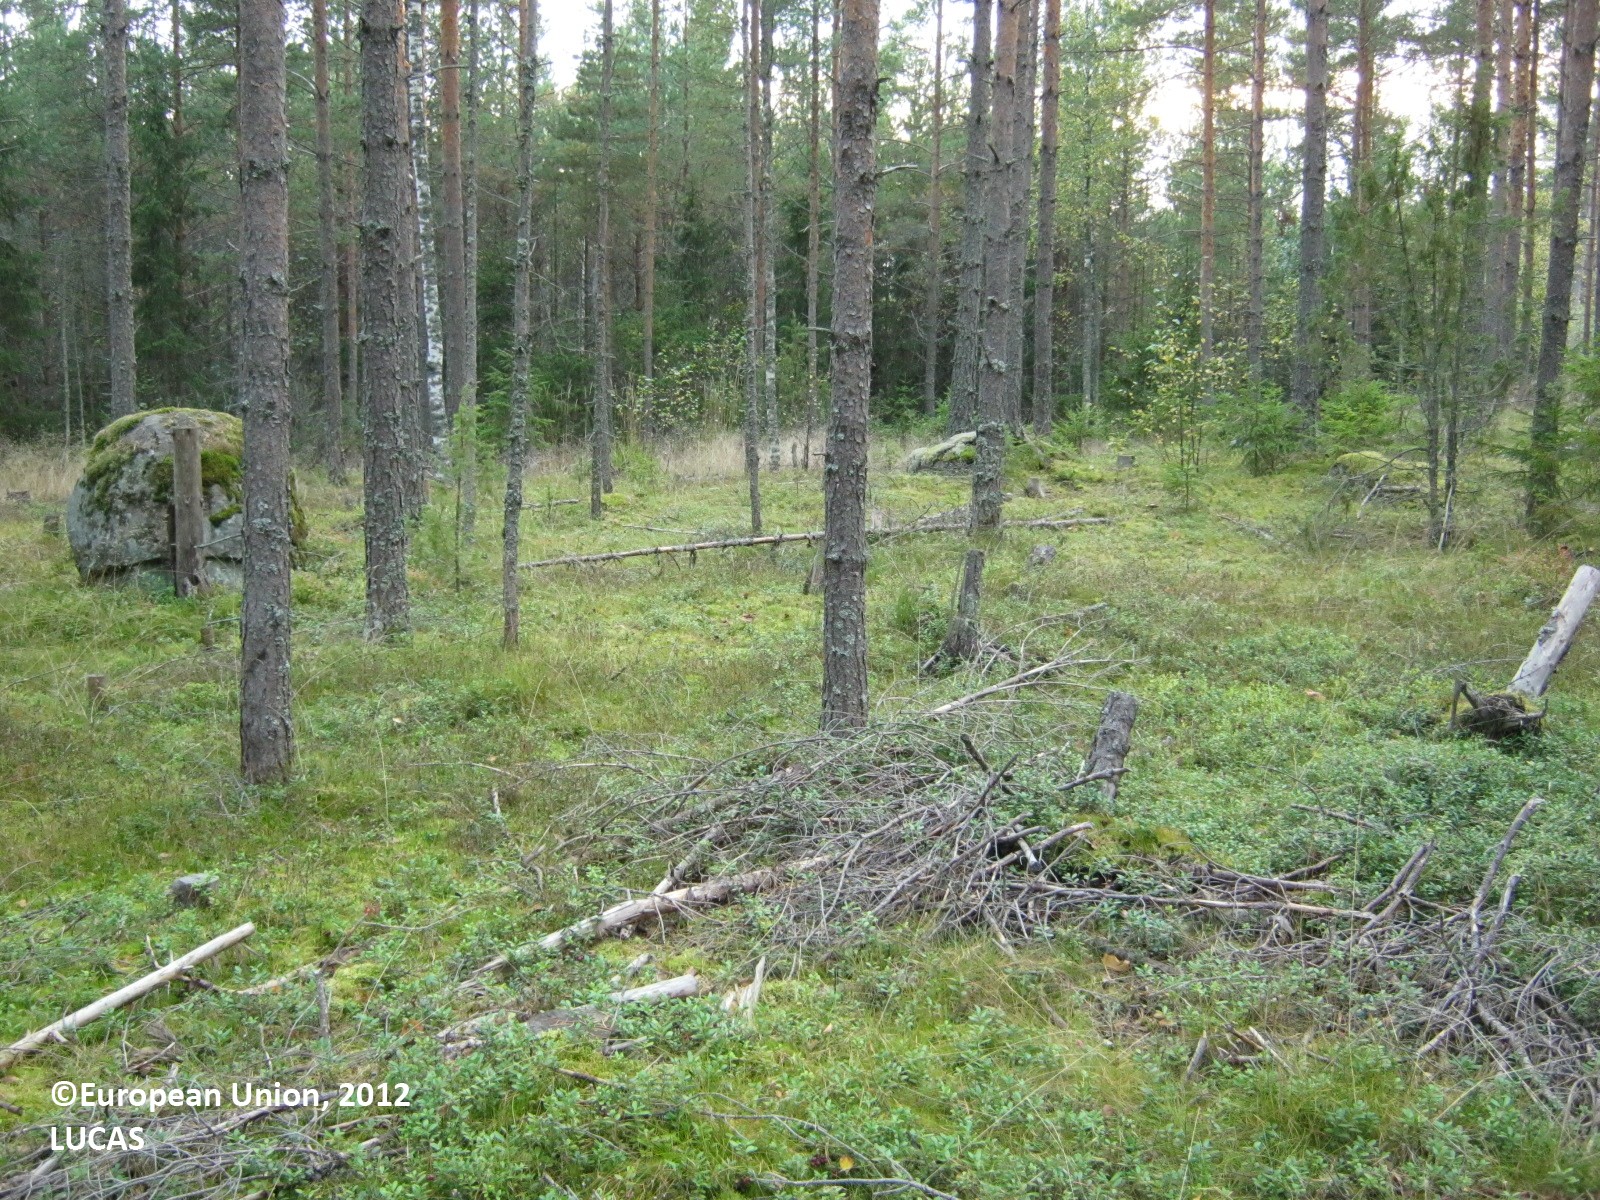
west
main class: Woodland
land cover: Pine dominated coniferous woodland
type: boreal forest
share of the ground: 50 - 75 %
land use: Forestry
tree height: > 5 m
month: September
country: FI
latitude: 60.8006
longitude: 28.0452
